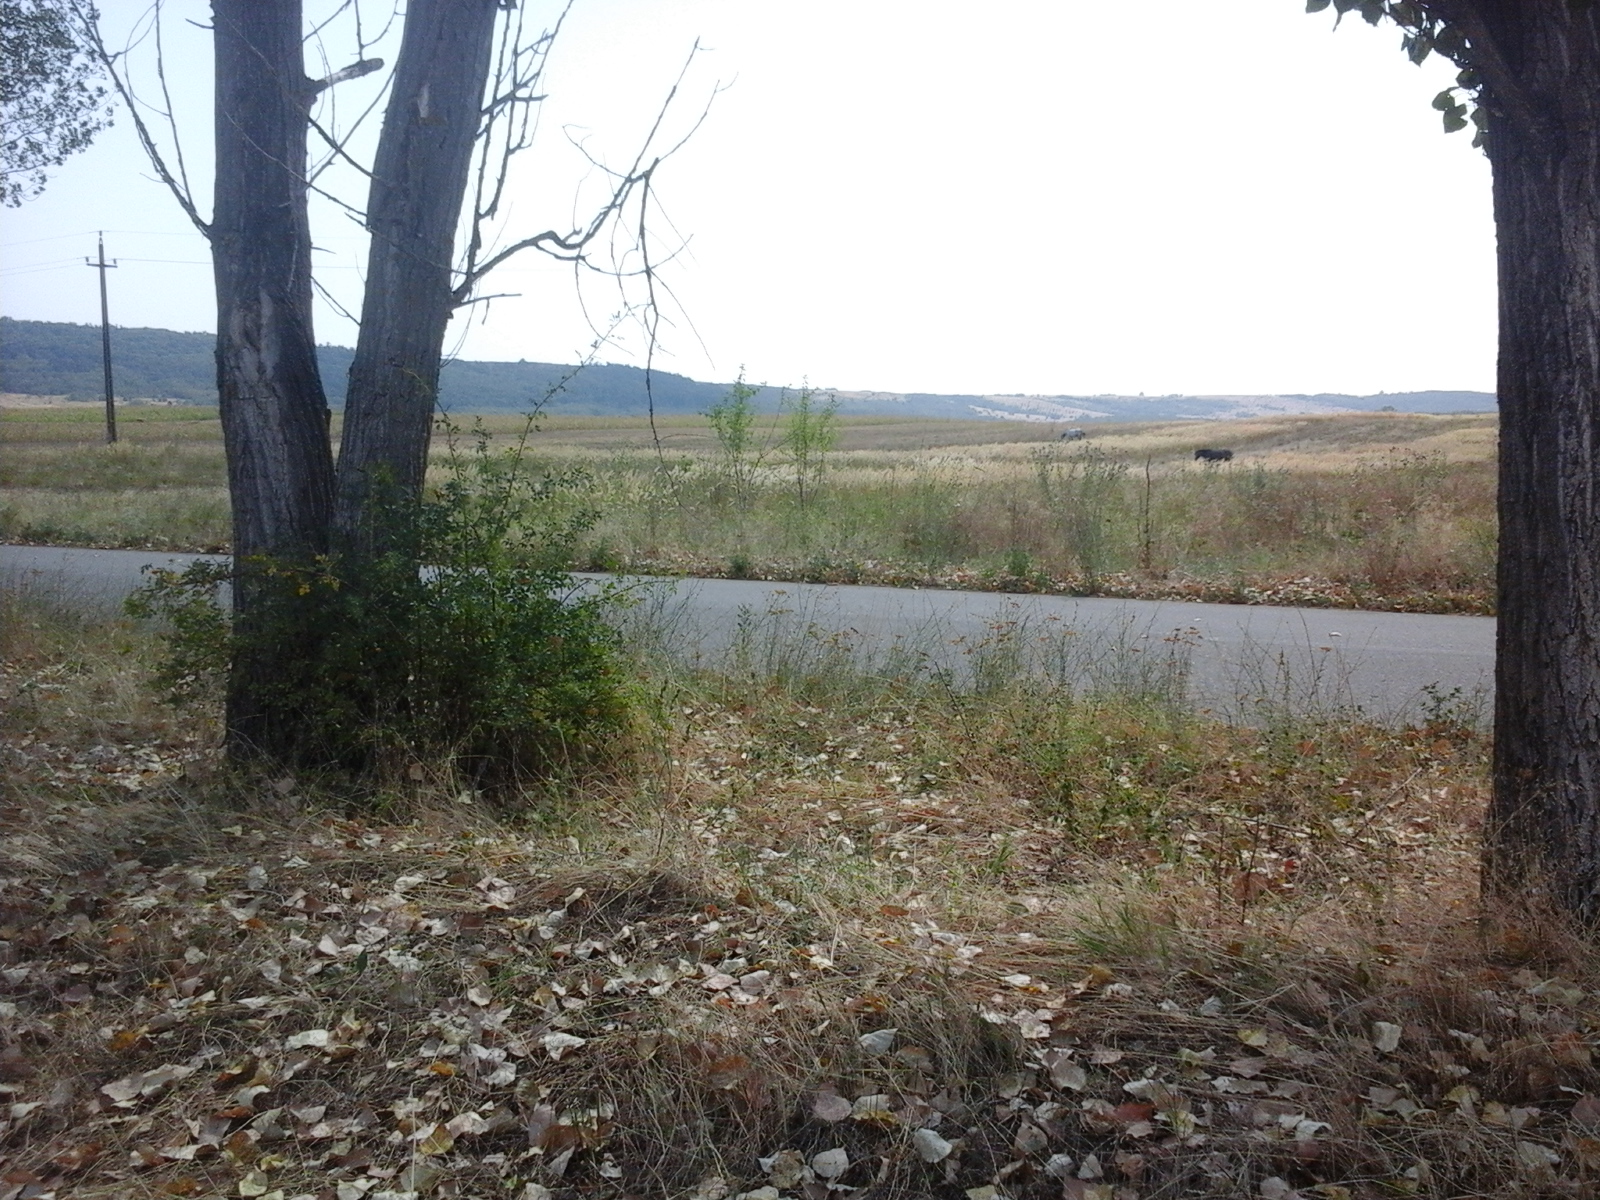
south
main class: Grassland
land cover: Grassland without tree/shrub cover
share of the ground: > 75 %
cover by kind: herbaceous plants 100 %
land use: Agriculture (excluding fallow land and kitchen gardens)
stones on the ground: < 10 %
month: August
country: RO
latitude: 44.5200
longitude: 22.6597
